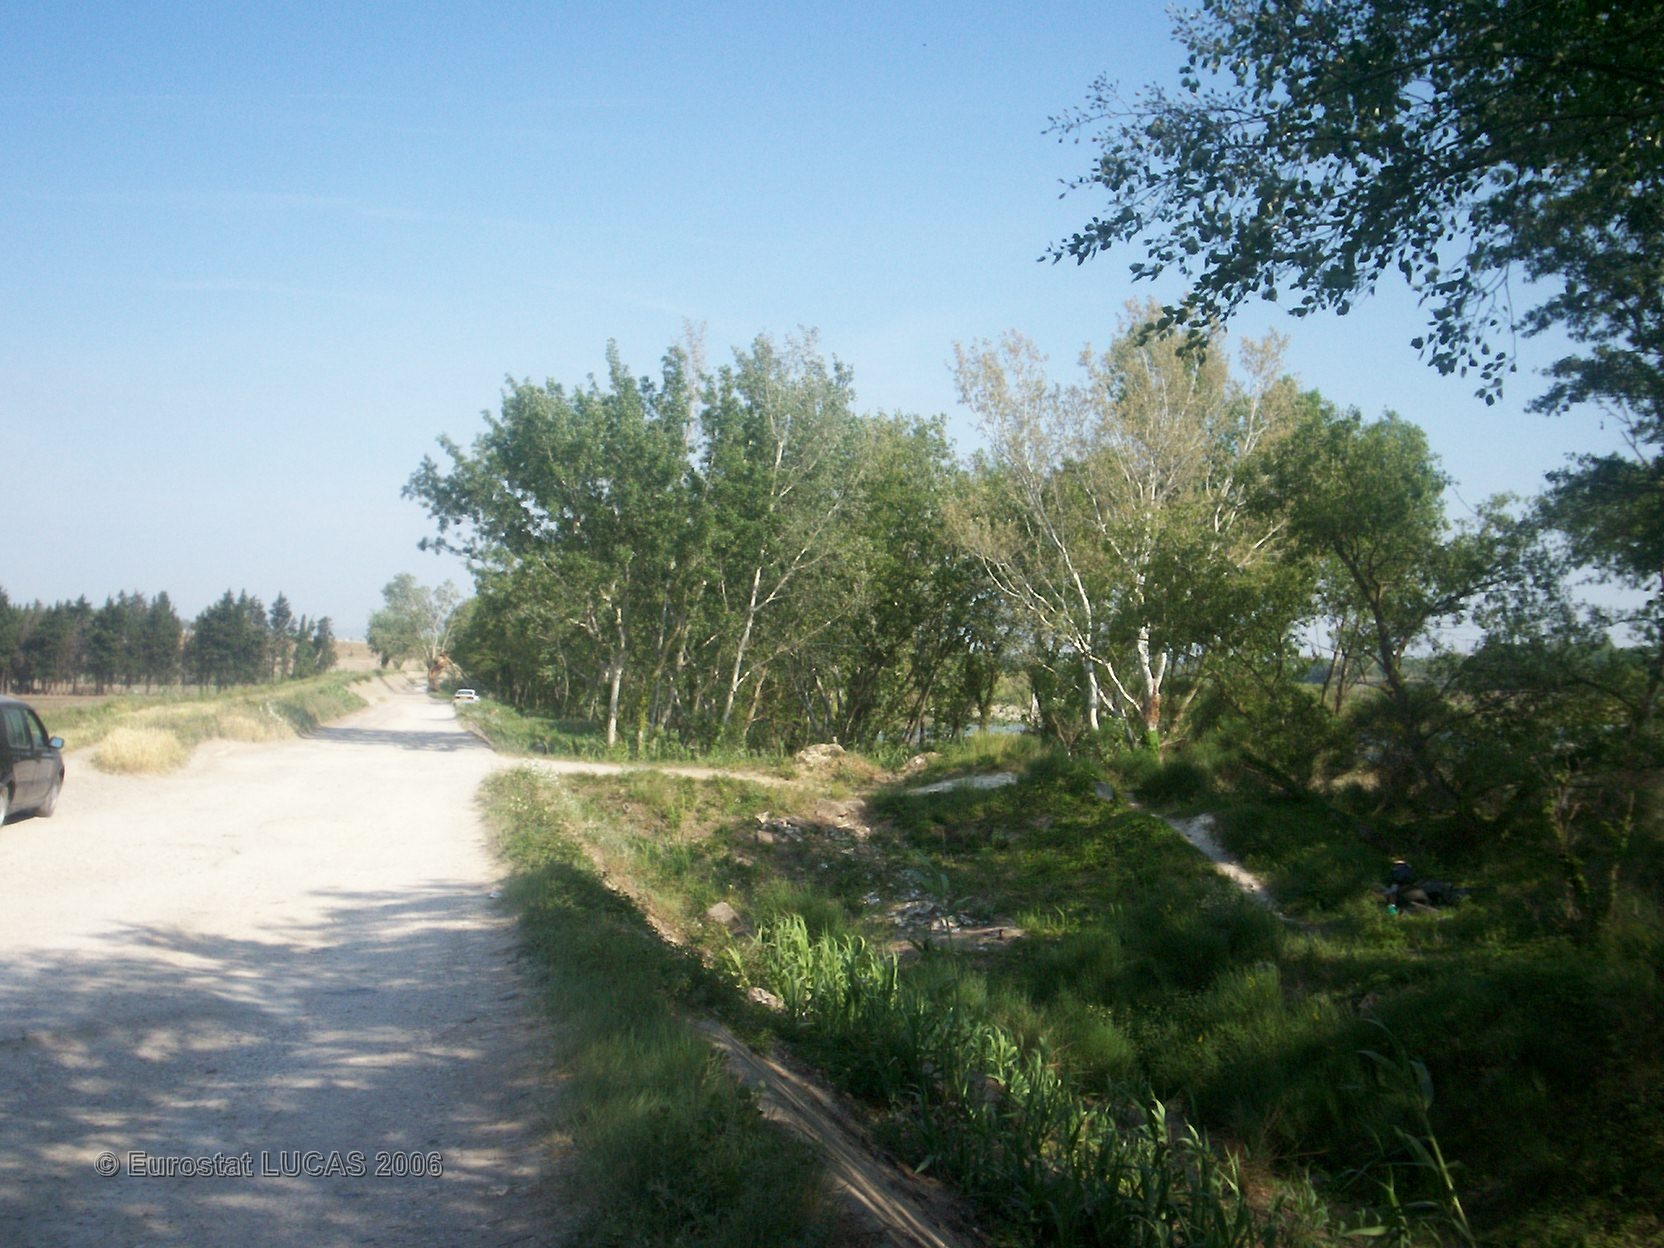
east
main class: Grassland
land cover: Grassland without tree/shrub cover
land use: Agriculture (excluding fallow land and kitchen gardens)
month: May
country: FR
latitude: 43.8995
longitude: 4.8918
